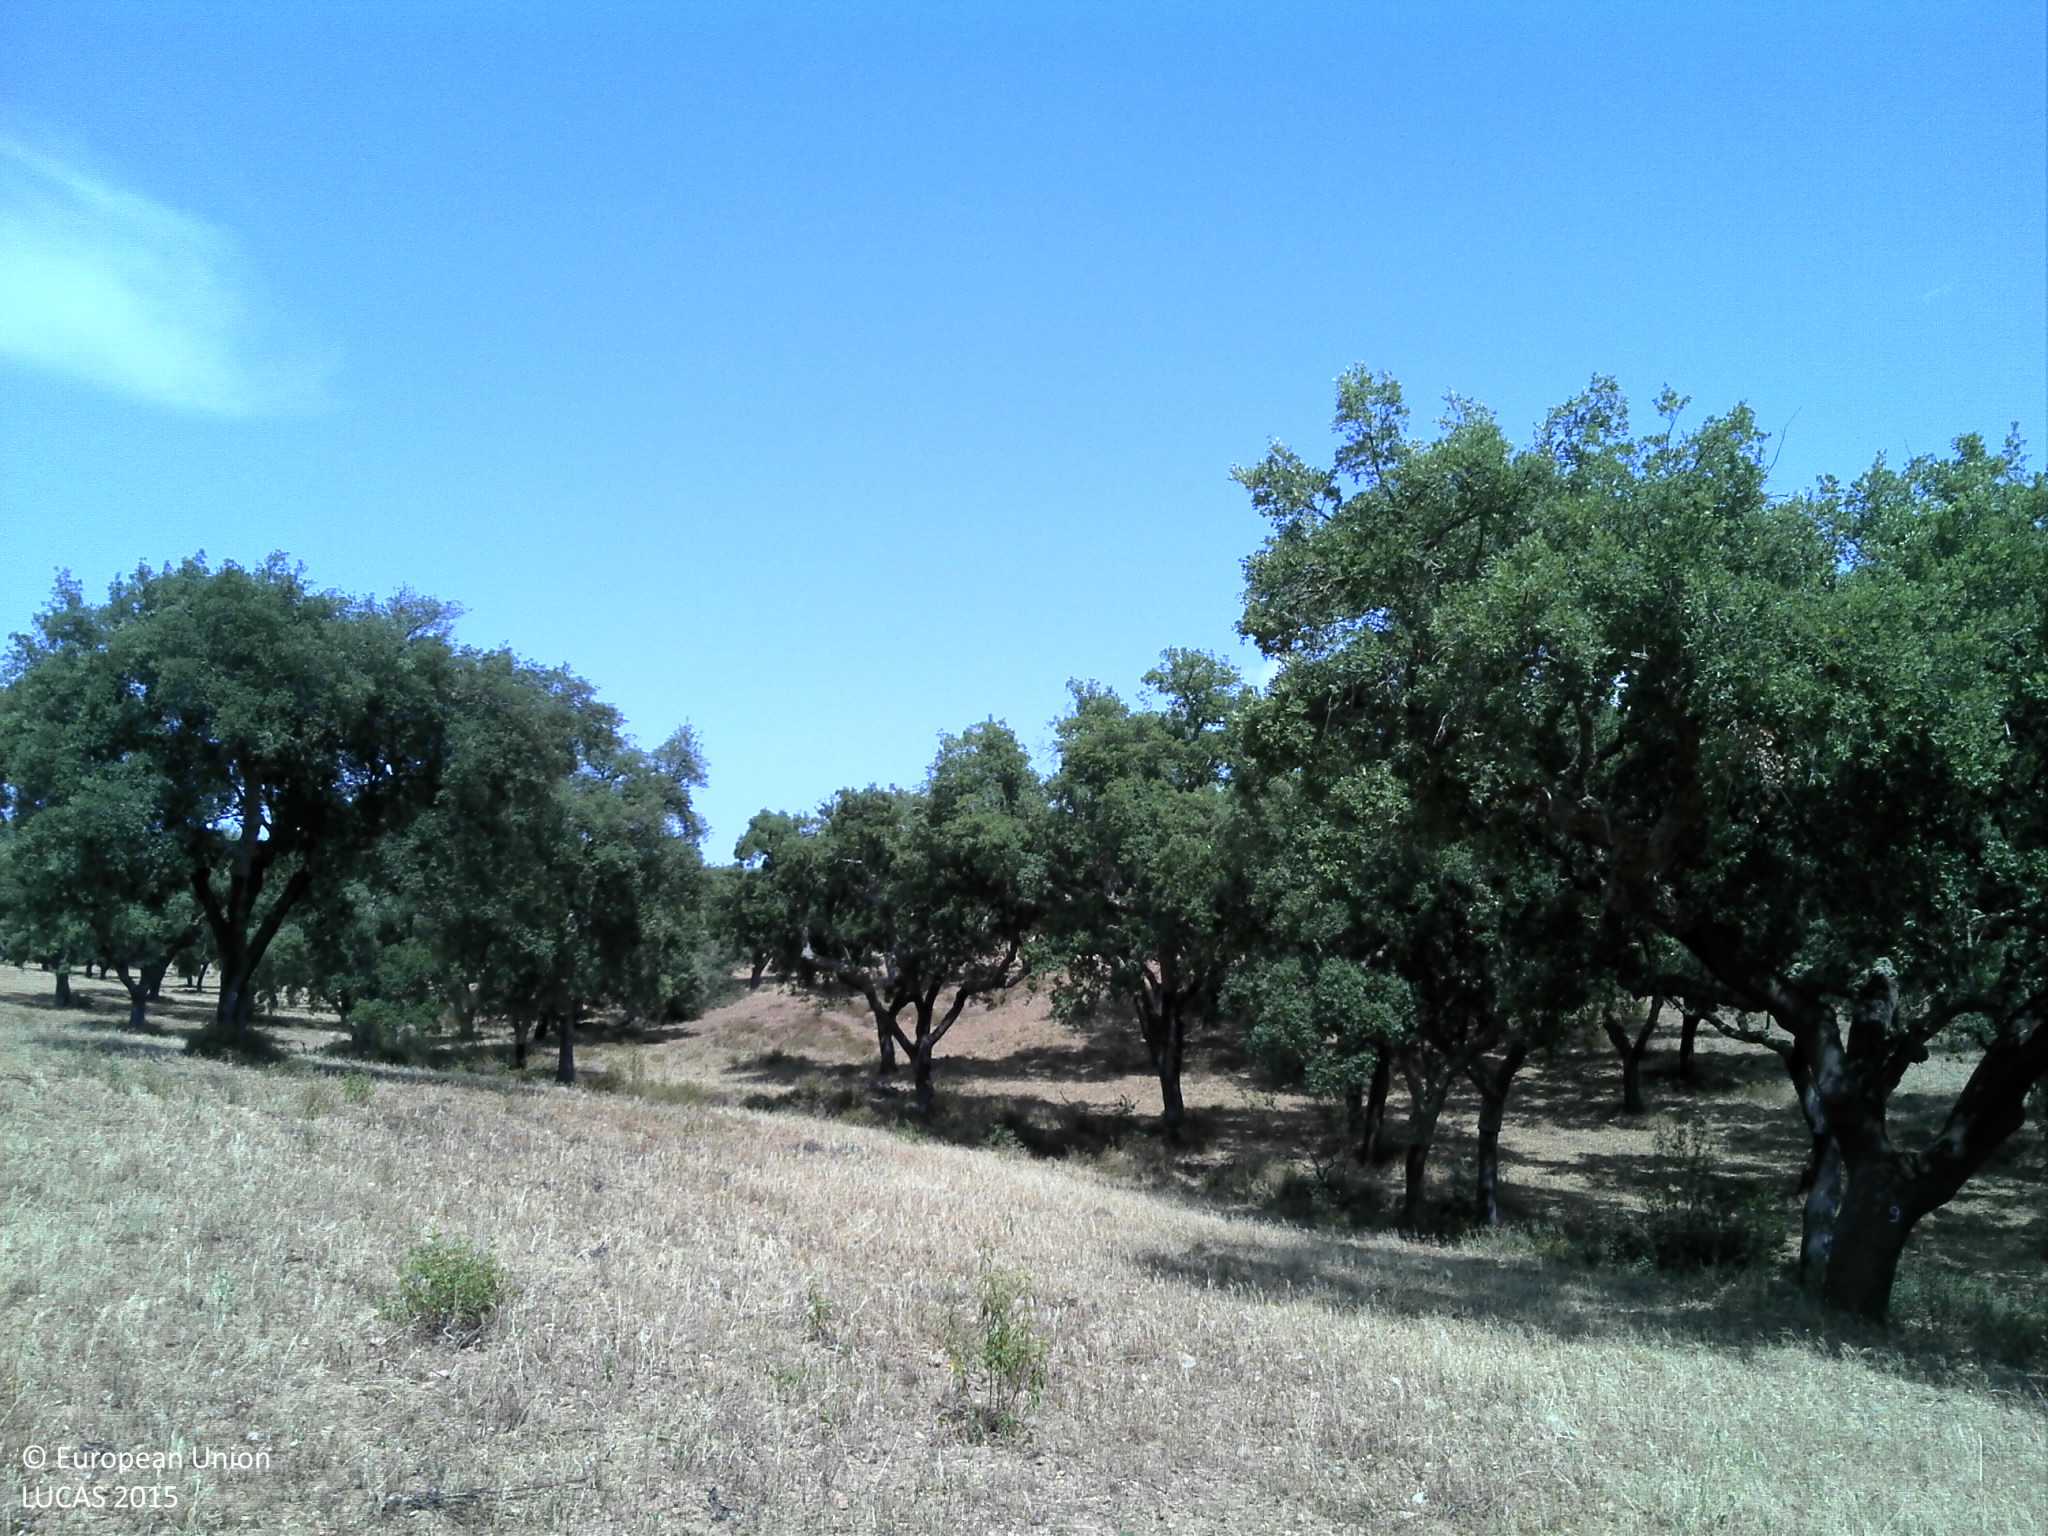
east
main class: Woodland
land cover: Broadleaved woodland
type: broadleaved evergreen forest
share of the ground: 10 - 25 %
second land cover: Grassland without tree/shrub cover
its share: 10 - 25 %
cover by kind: unconsolidated bare surface 70 %, broadleaved forest trees 15 %, herbaceous plants 15 %
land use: Forestry
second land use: Agriculture (excluding fallow land and kitchen gardens)
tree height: > 5 m
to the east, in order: Broadleaved woodland; Grassland without tree/shrub cover; Broadleaved woodland; Rivers and streams; Broadleaved woodland
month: June
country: PT
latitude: 38.6268
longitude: -7.6902
